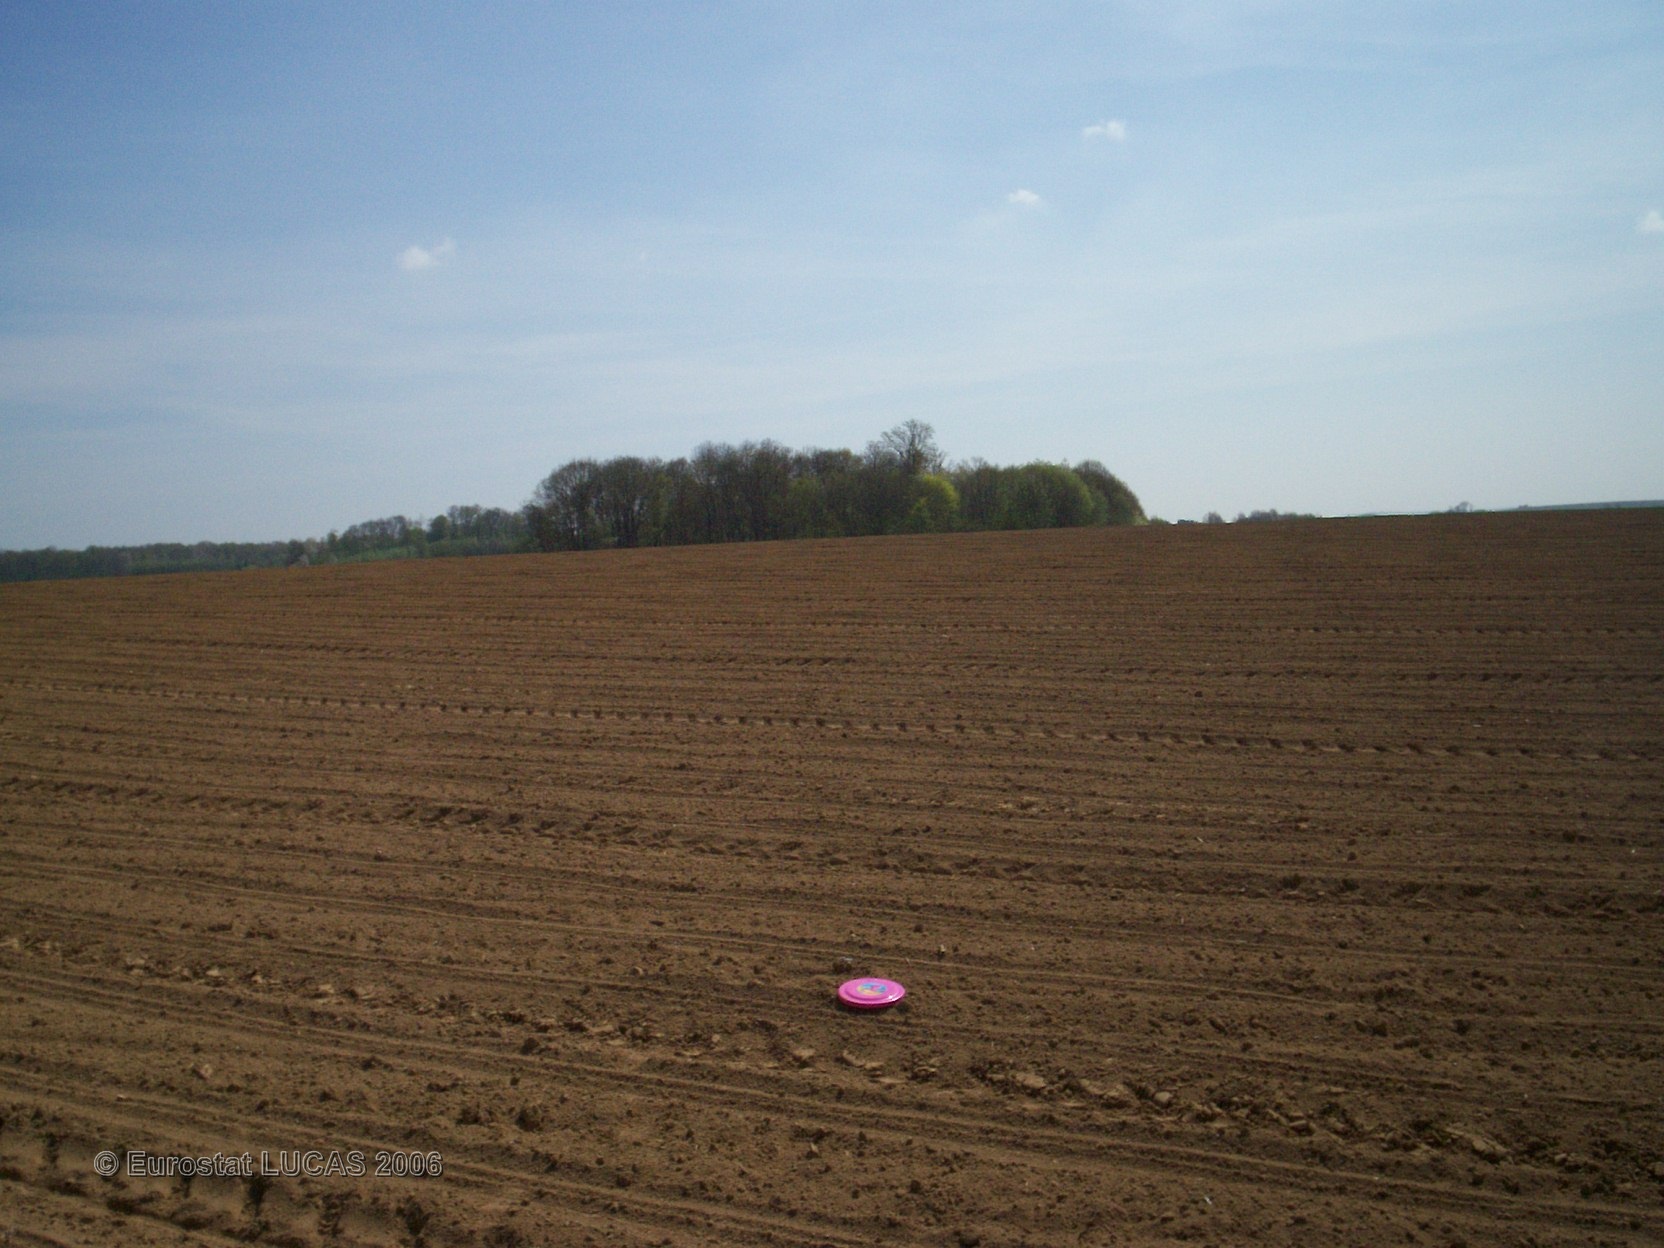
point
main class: Cropland
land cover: Maize
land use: Agriculture (excluding fallow land and kitchen gardens)
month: April
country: FR
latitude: 49.6315
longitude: 4.3885
